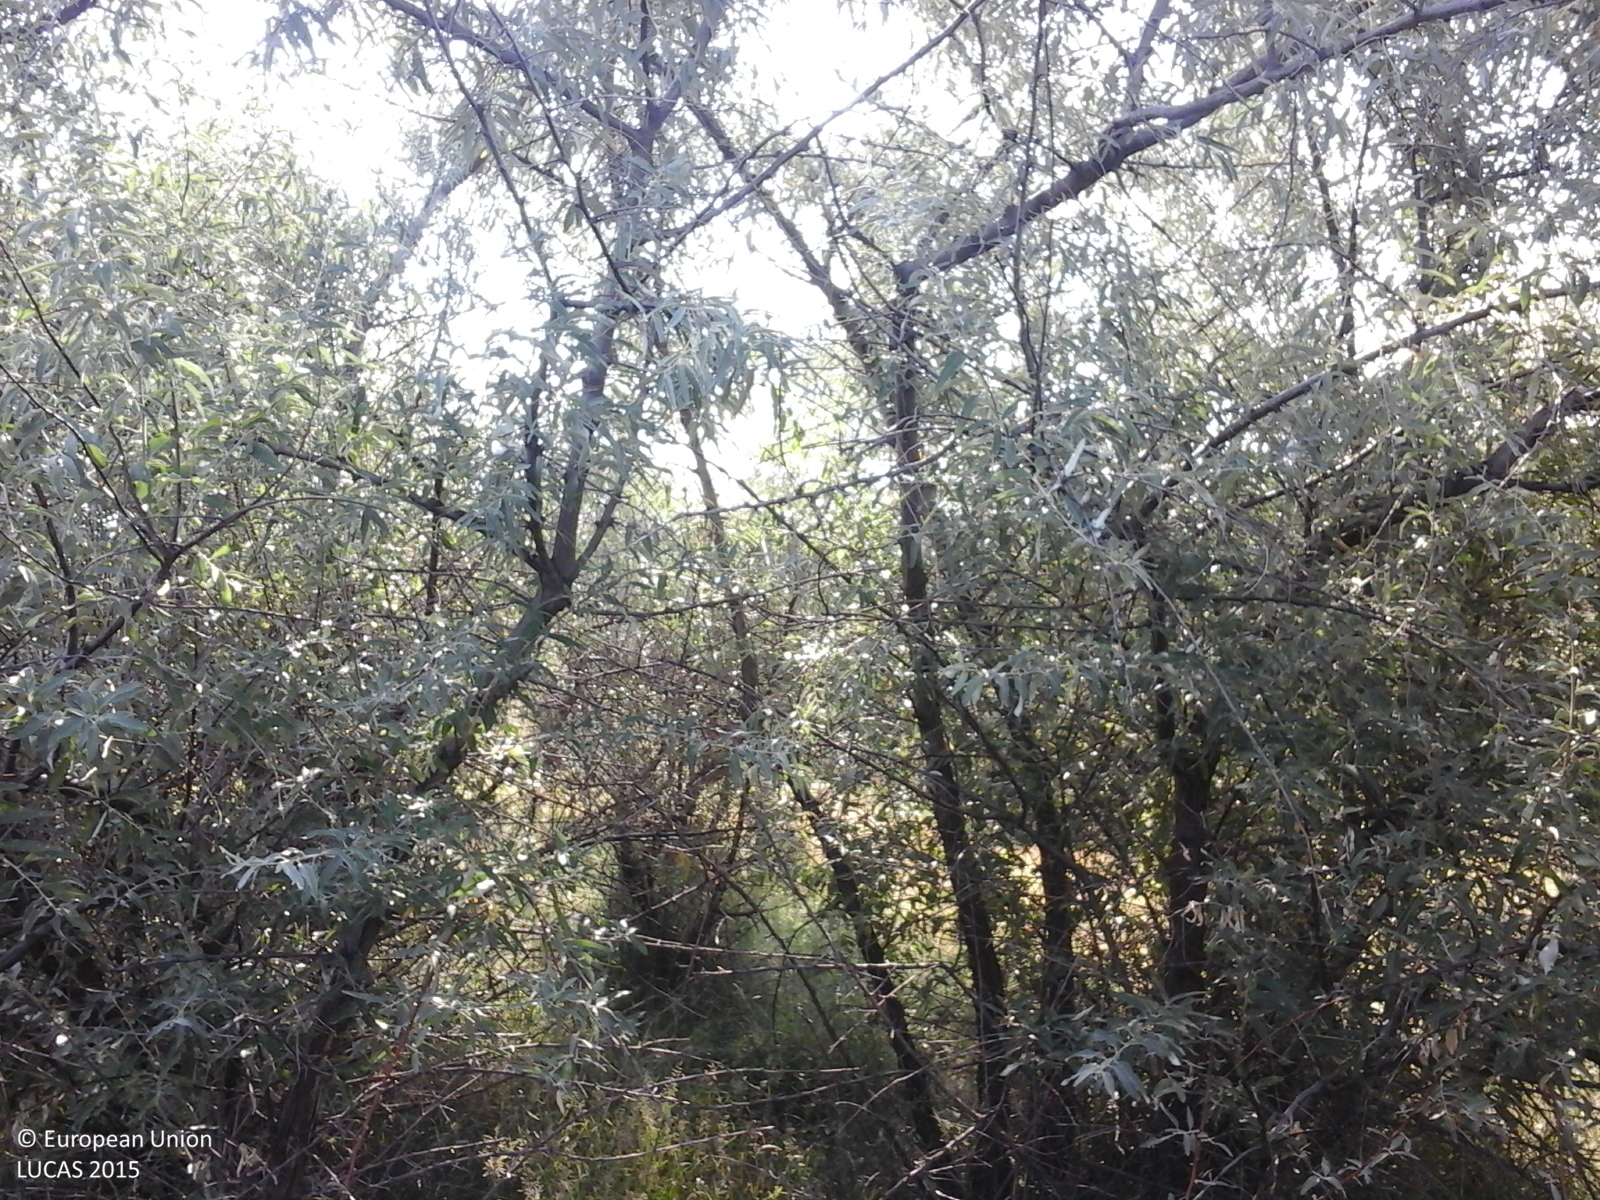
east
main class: Shrubland
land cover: Shrubland without tree cover
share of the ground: > 75 %
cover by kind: shrubs 70 %, herbaceous plants 30 %
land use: Agriculture (excluding fallow land and kitchen gardens)
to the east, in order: Shrubland without tree cover; Tracks; Shrubland without tree cover; Tracks; Shrubland without tree cover
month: July
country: RO
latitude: 46.5313
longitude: 28.1632
